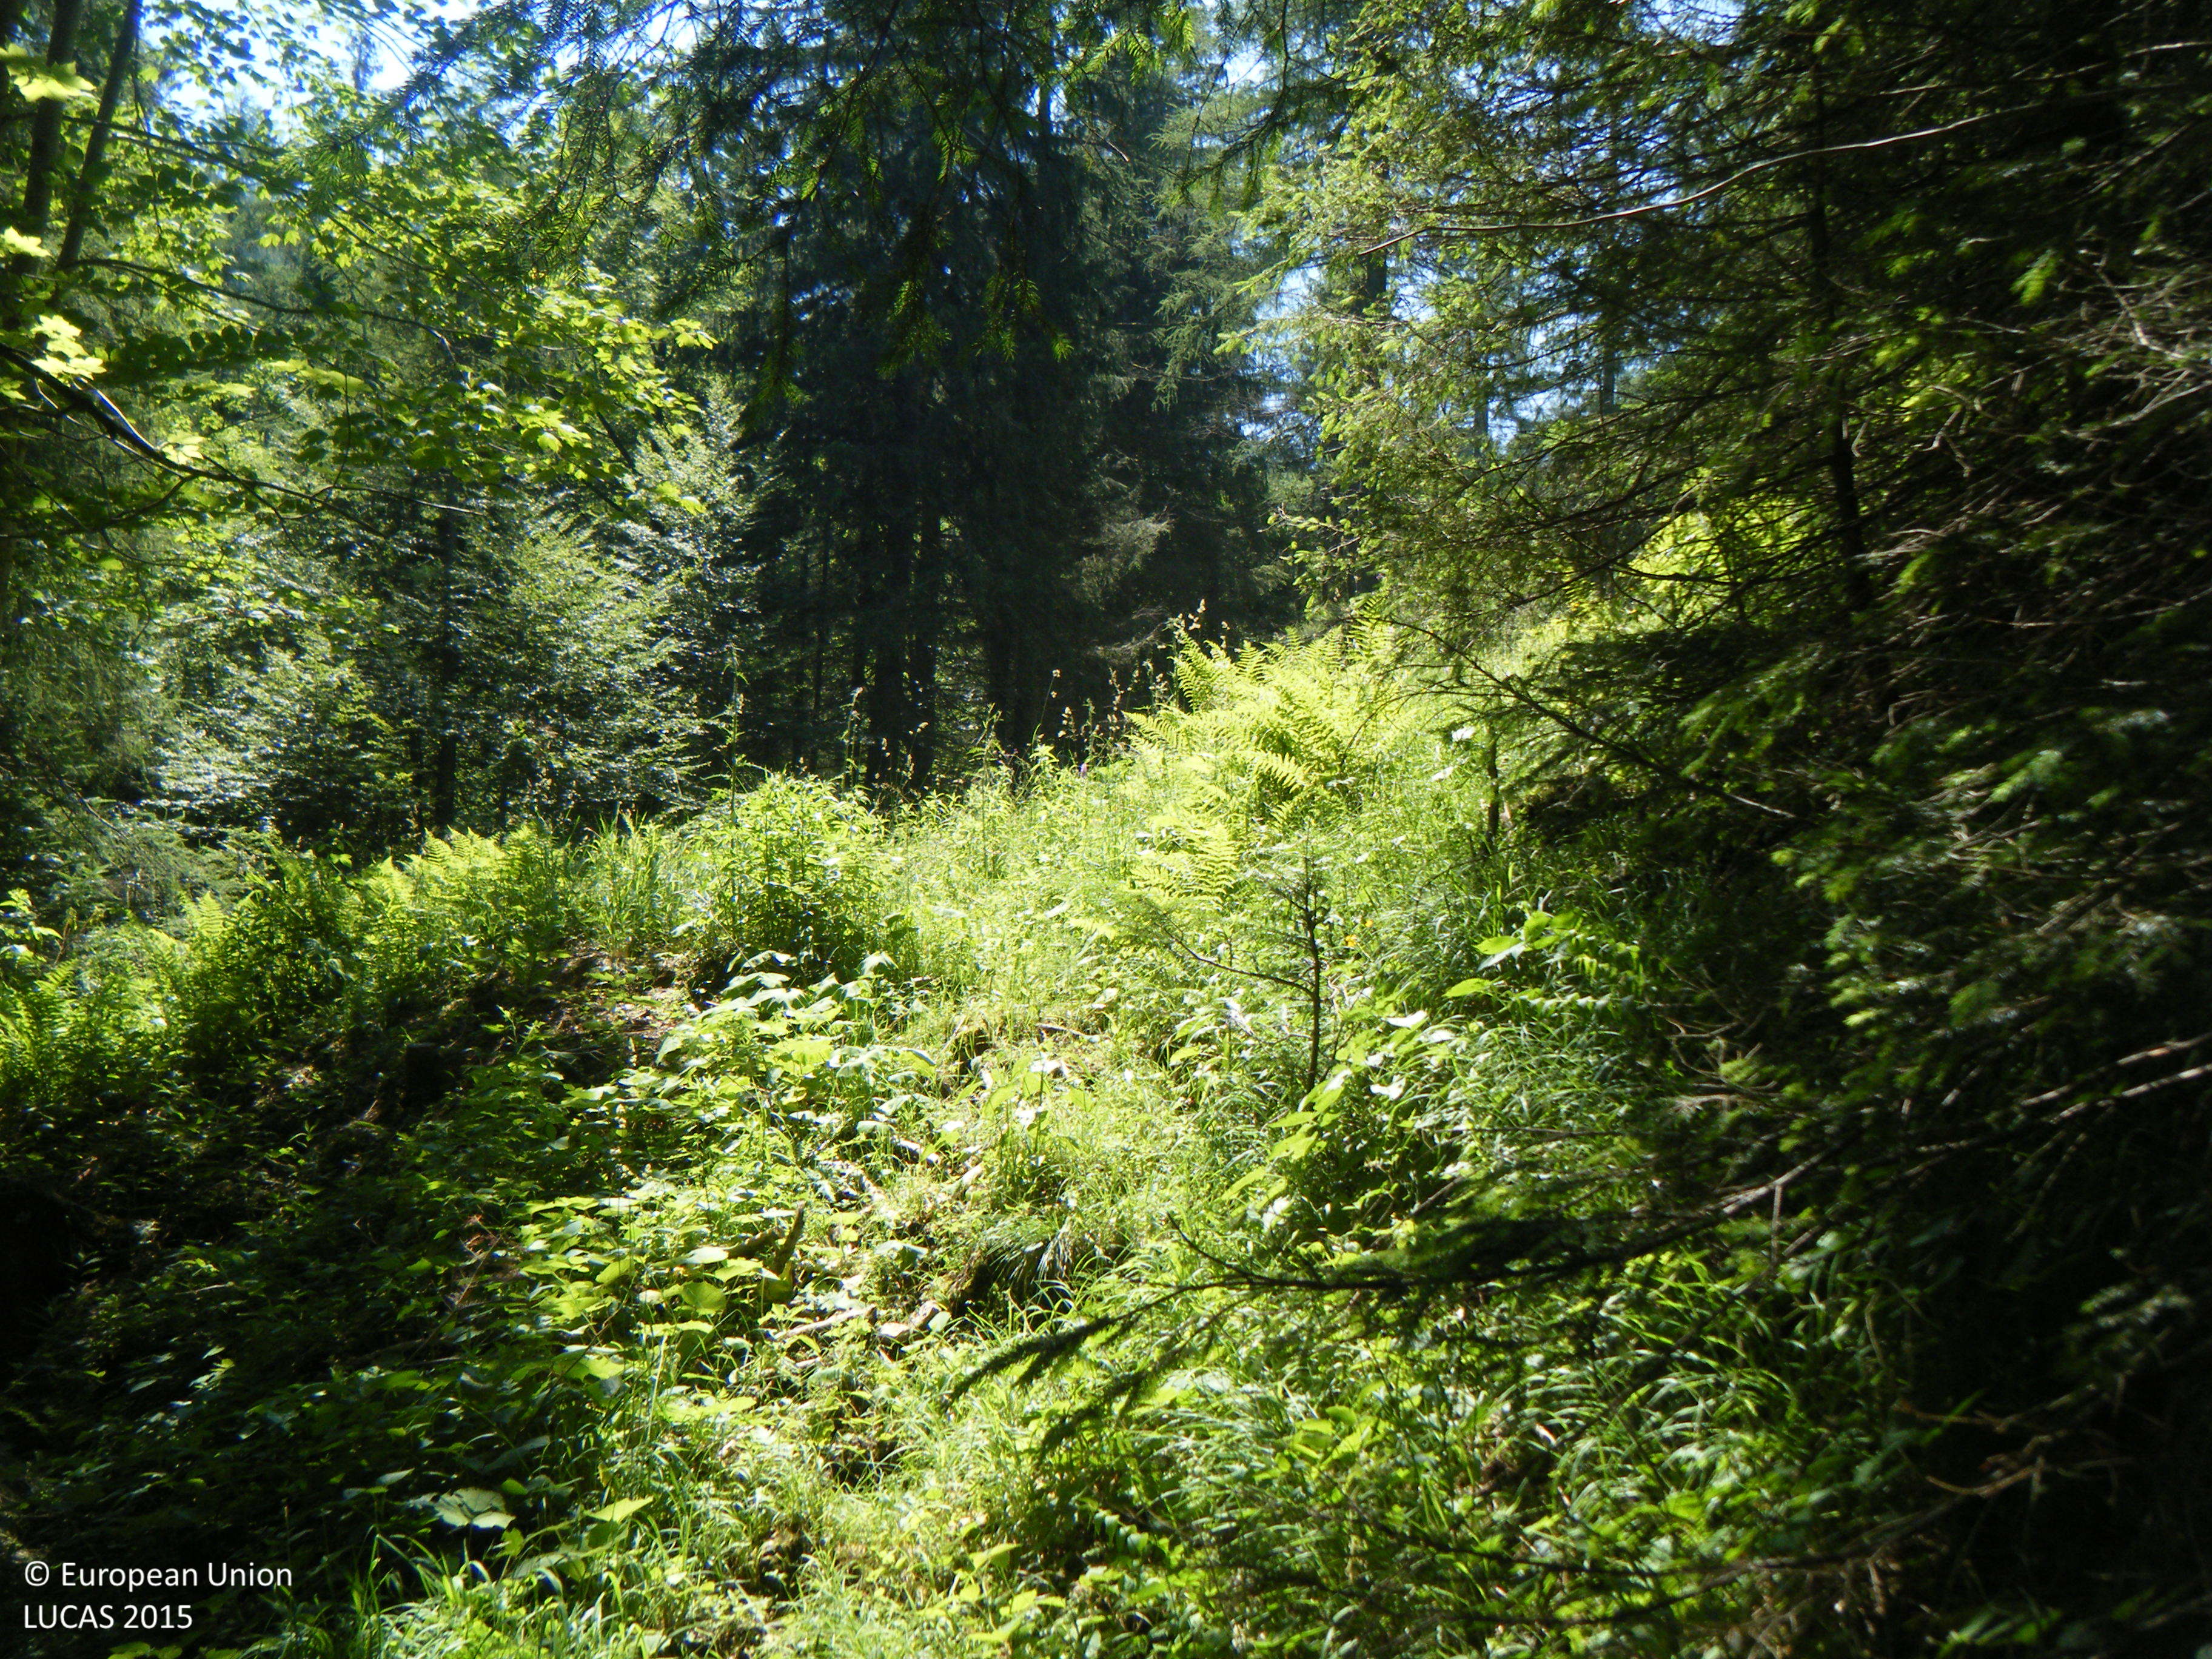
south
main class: Woodland
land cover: Spruce dominated mixed woodland
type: alpine coniferous forest
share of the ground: > 75 %
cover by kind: coniferous forest trees 60 %, broadleaved forest trees 25 %, herbaceous plants 15 %
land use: Forestry
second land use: Agriculture (excluding fallow land and kitchen gardens)
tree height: > 5 m
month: July
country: AT
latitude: 47.7593
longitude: 13.3205
